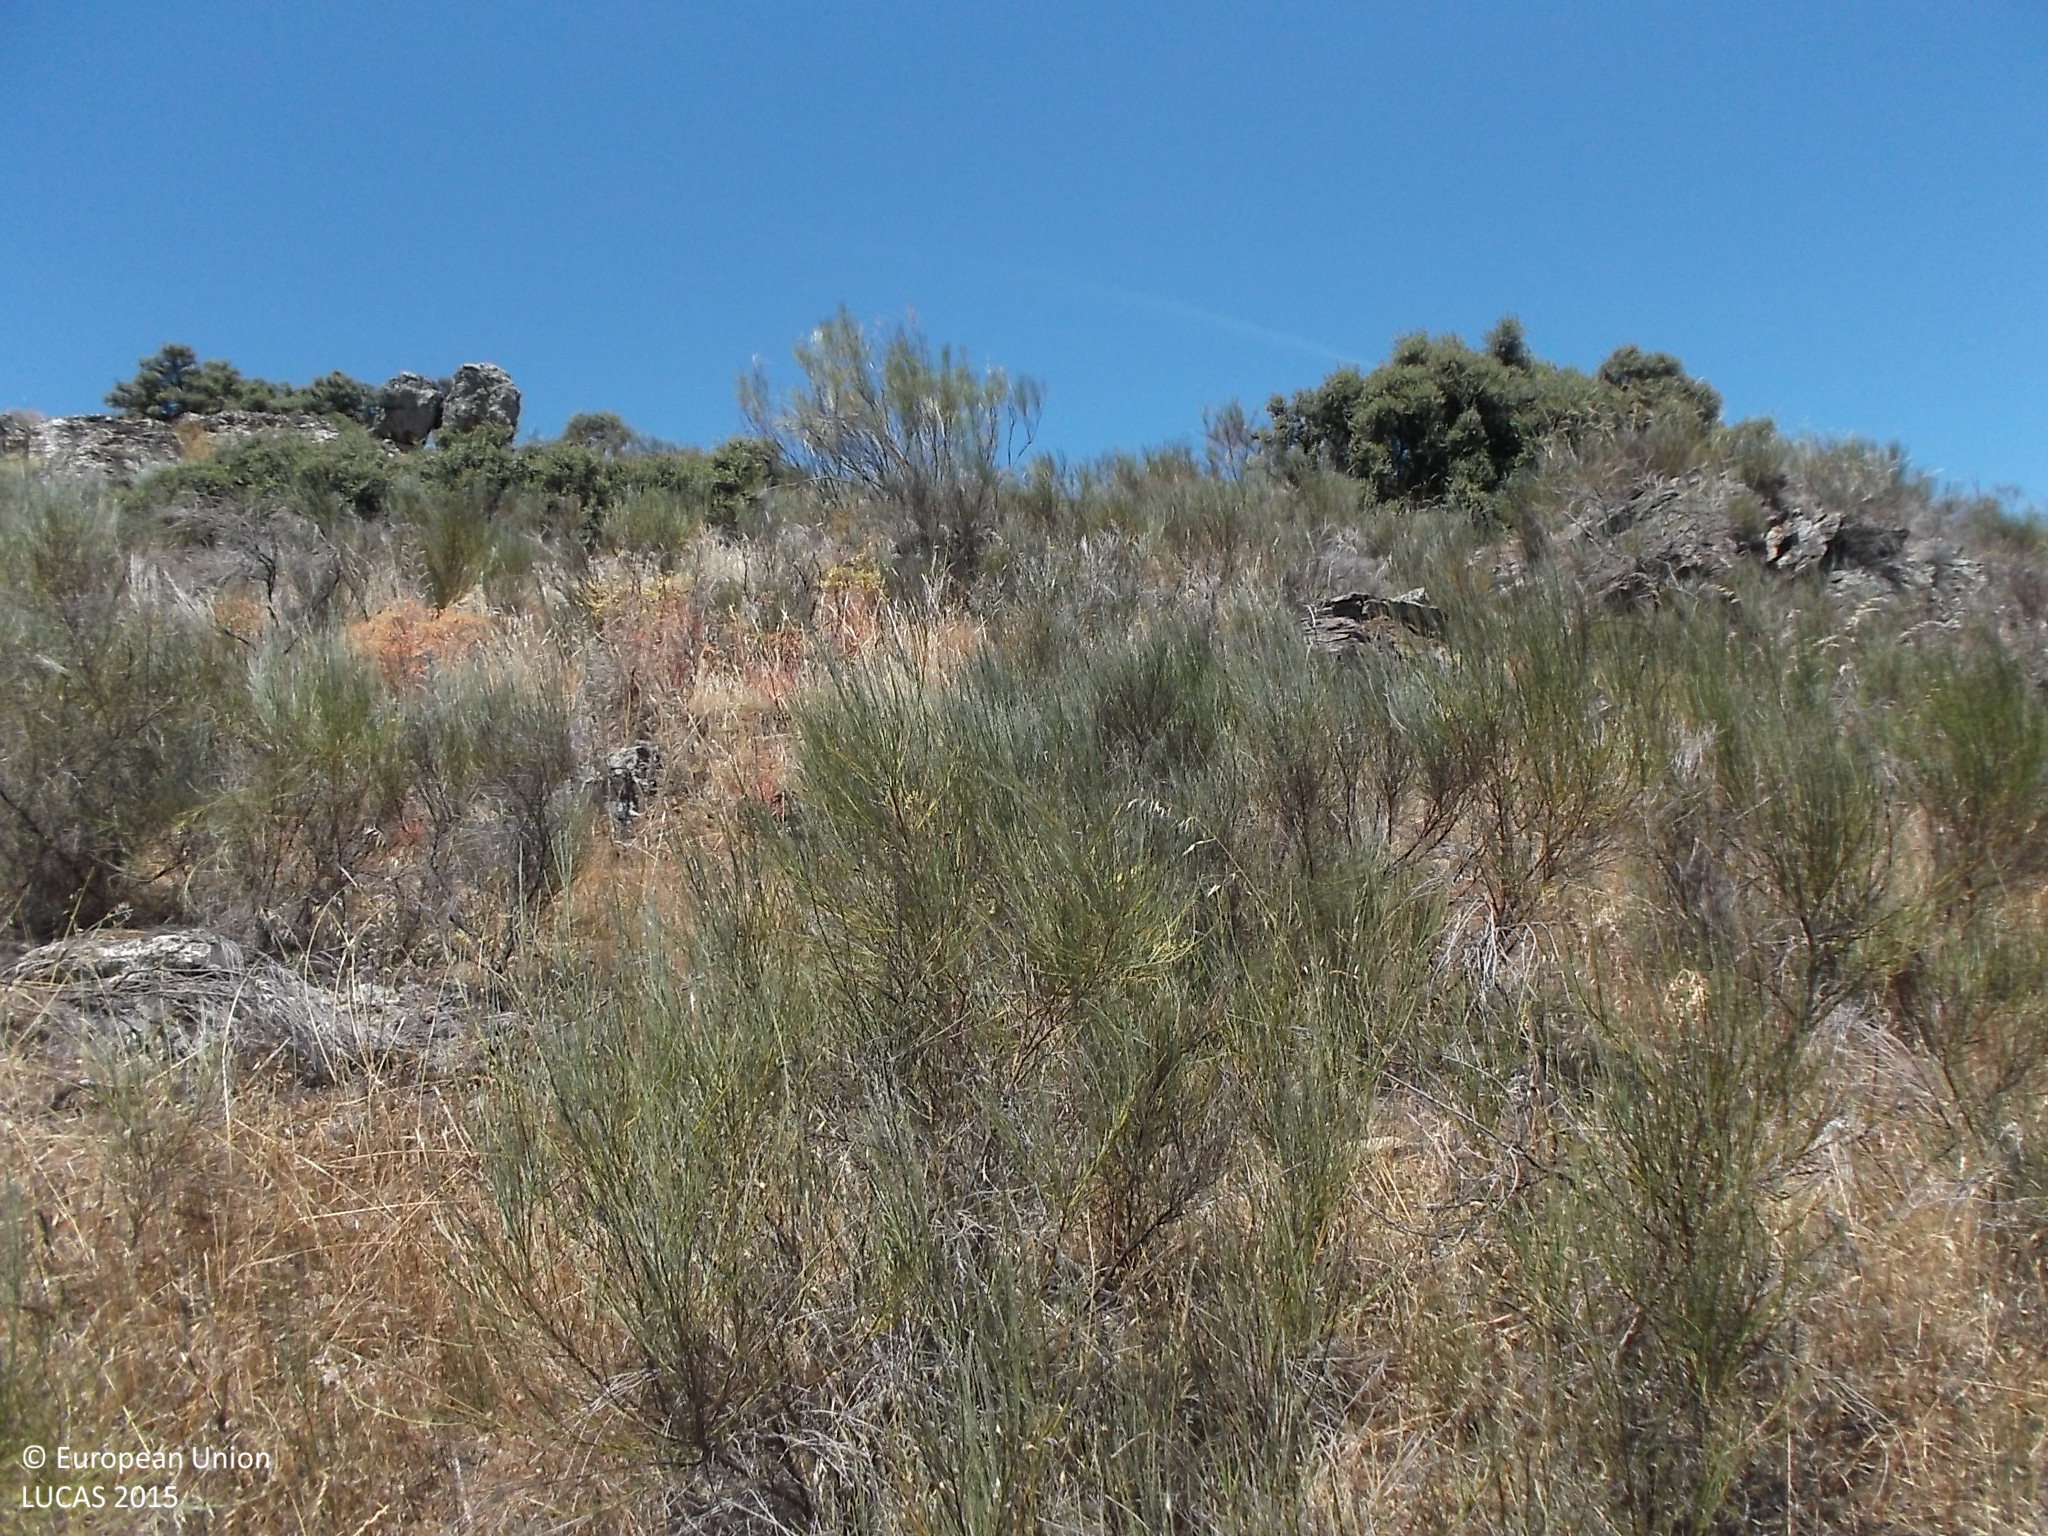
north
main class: Shrubland
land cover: Shrubland without tree cover
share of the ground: > 75 %
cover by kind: shrubs 90 %, herbaceous plants 10 %
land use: Agriculture (excluding fallow land and kitchen gardens)
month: July
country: ES
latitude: 41.0123
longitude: -6.8333
